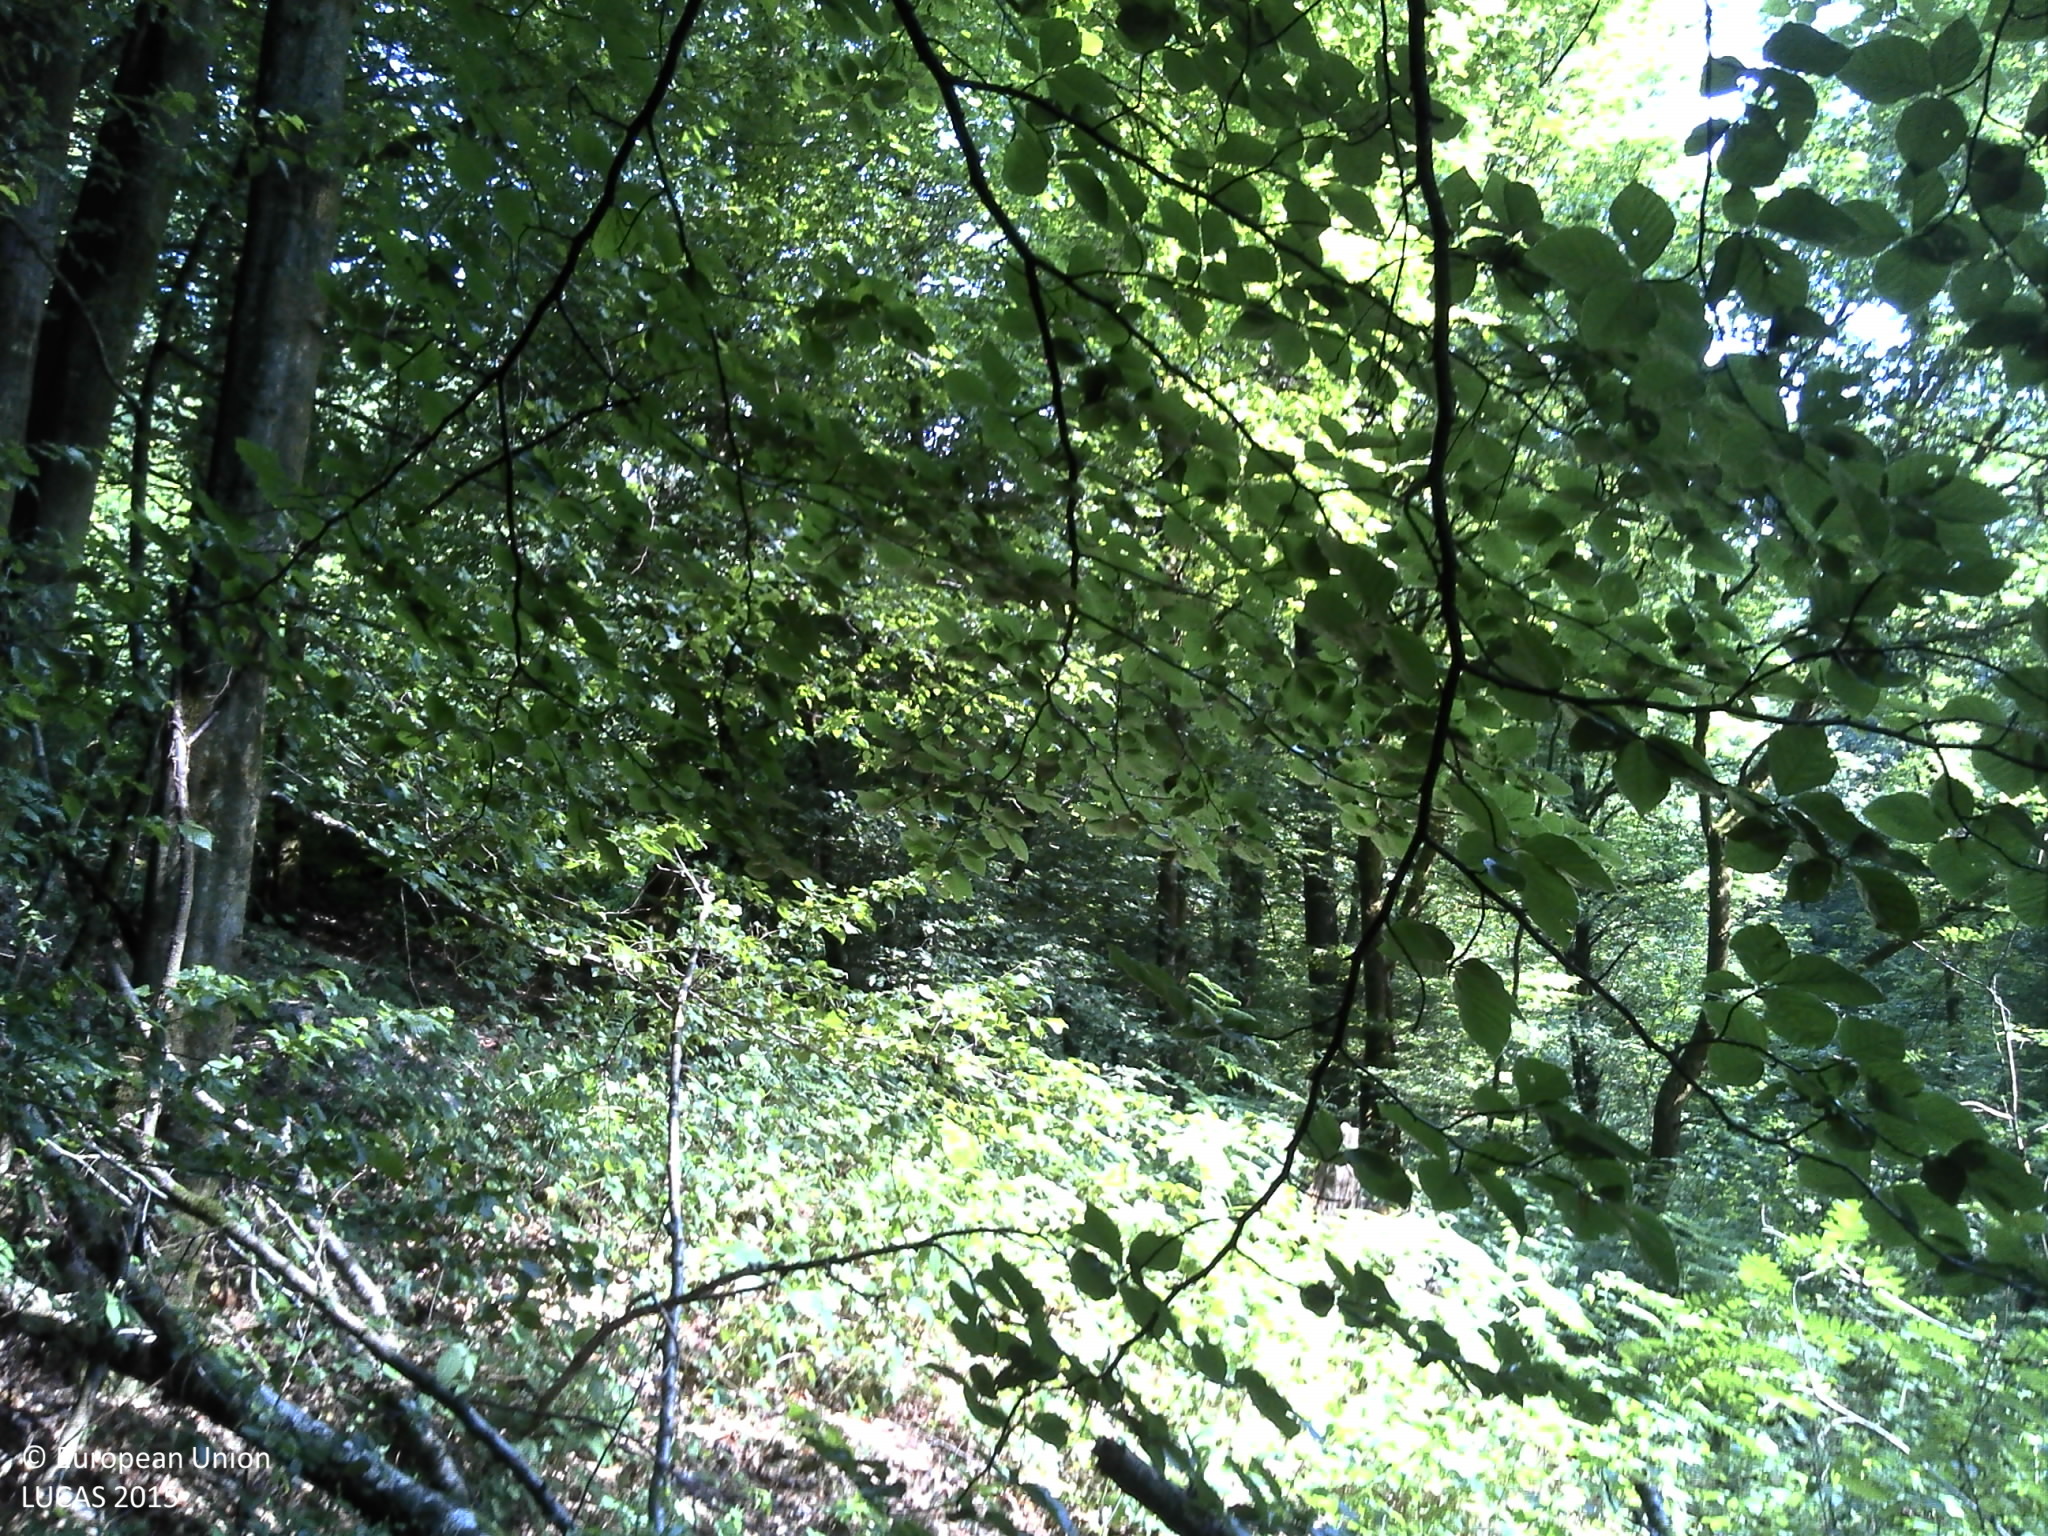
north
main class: Woodland
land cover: Broadleaved woodland
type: beech forest
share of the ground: 50 - 75 %
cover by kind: broadleaved forest trees 70 %, herbaceous plants 20 %, lichens and mosses 5 %, consolidated bare surface 5 %
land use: Forestry
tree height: > 5 m
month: July
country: FR
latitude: 49.9111
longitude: 4.5793
